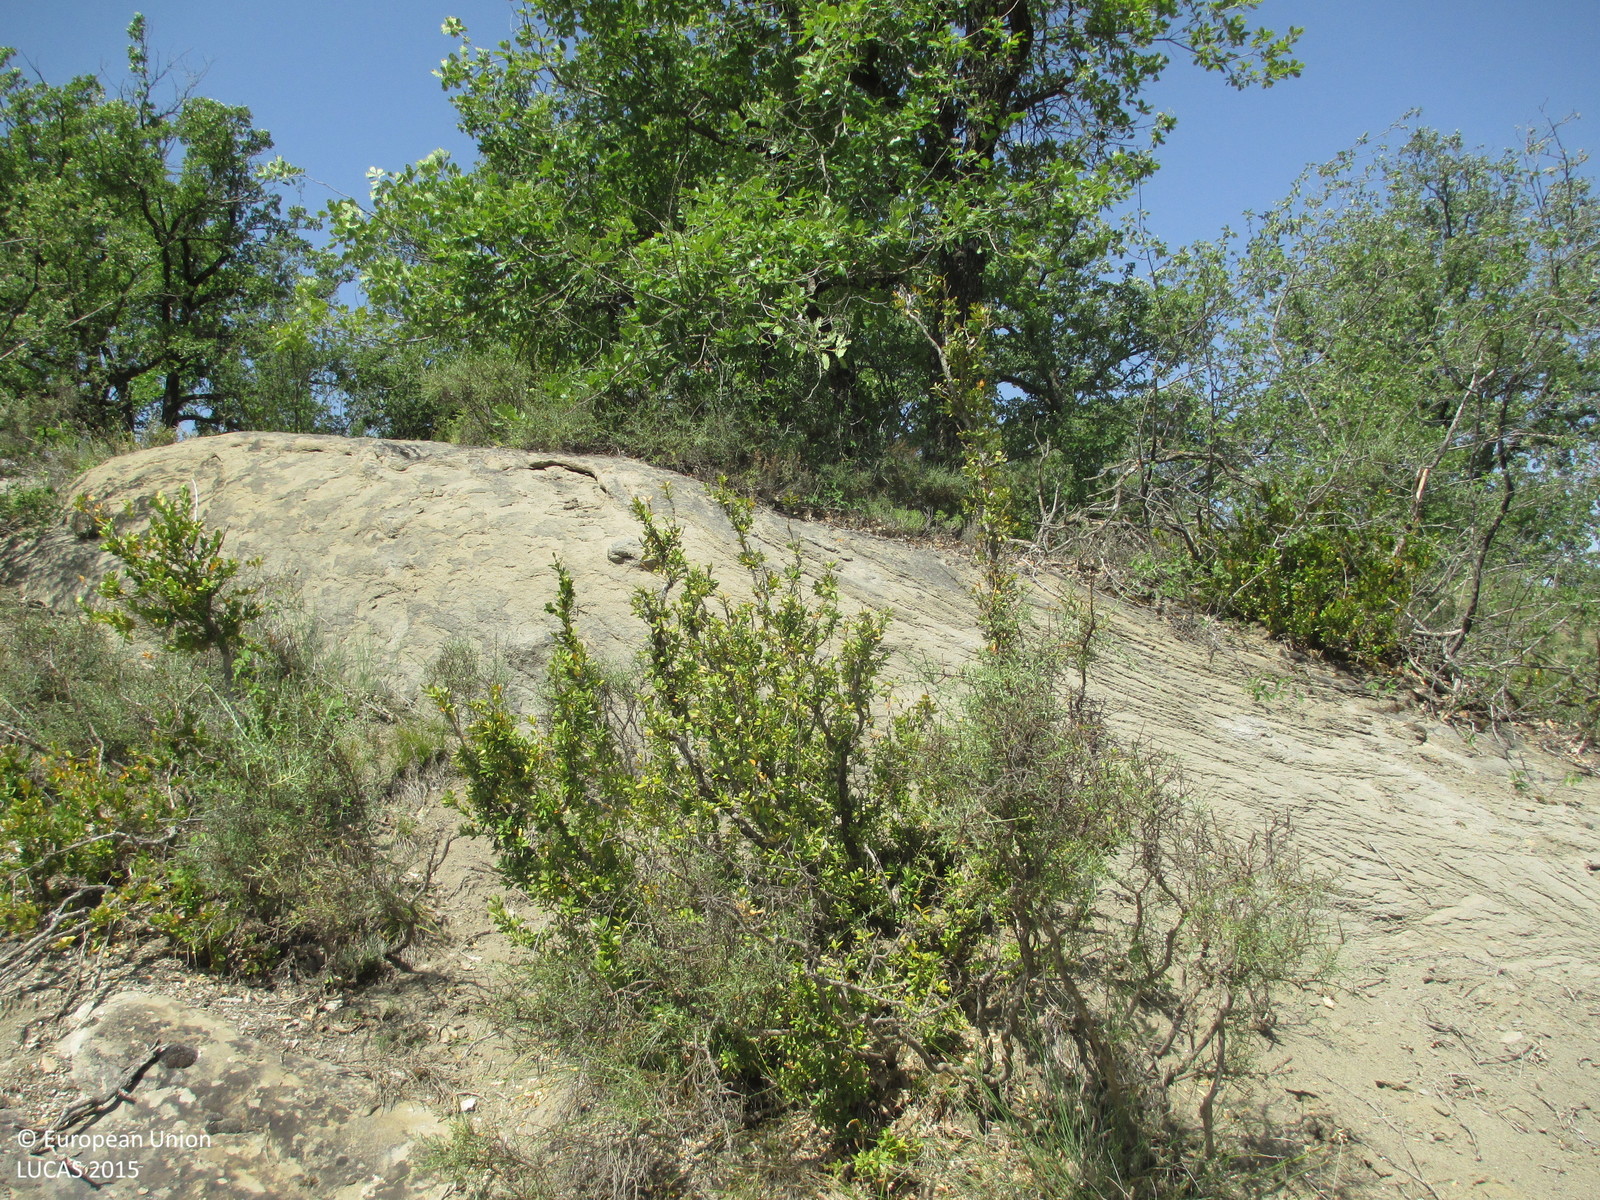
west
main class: Grassland
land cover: Grassland with sparse tree/shrub cover
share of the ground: > 75 %
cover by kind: herbaceous plants 85 %, coniferous forest trees 5 %, shrubs 5 %, consolidated bare surface 5 %
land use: Semi-natural and natural areas not in use
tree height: > 5 m
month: July
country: ES
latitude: 42.3712
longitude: -0.4073
